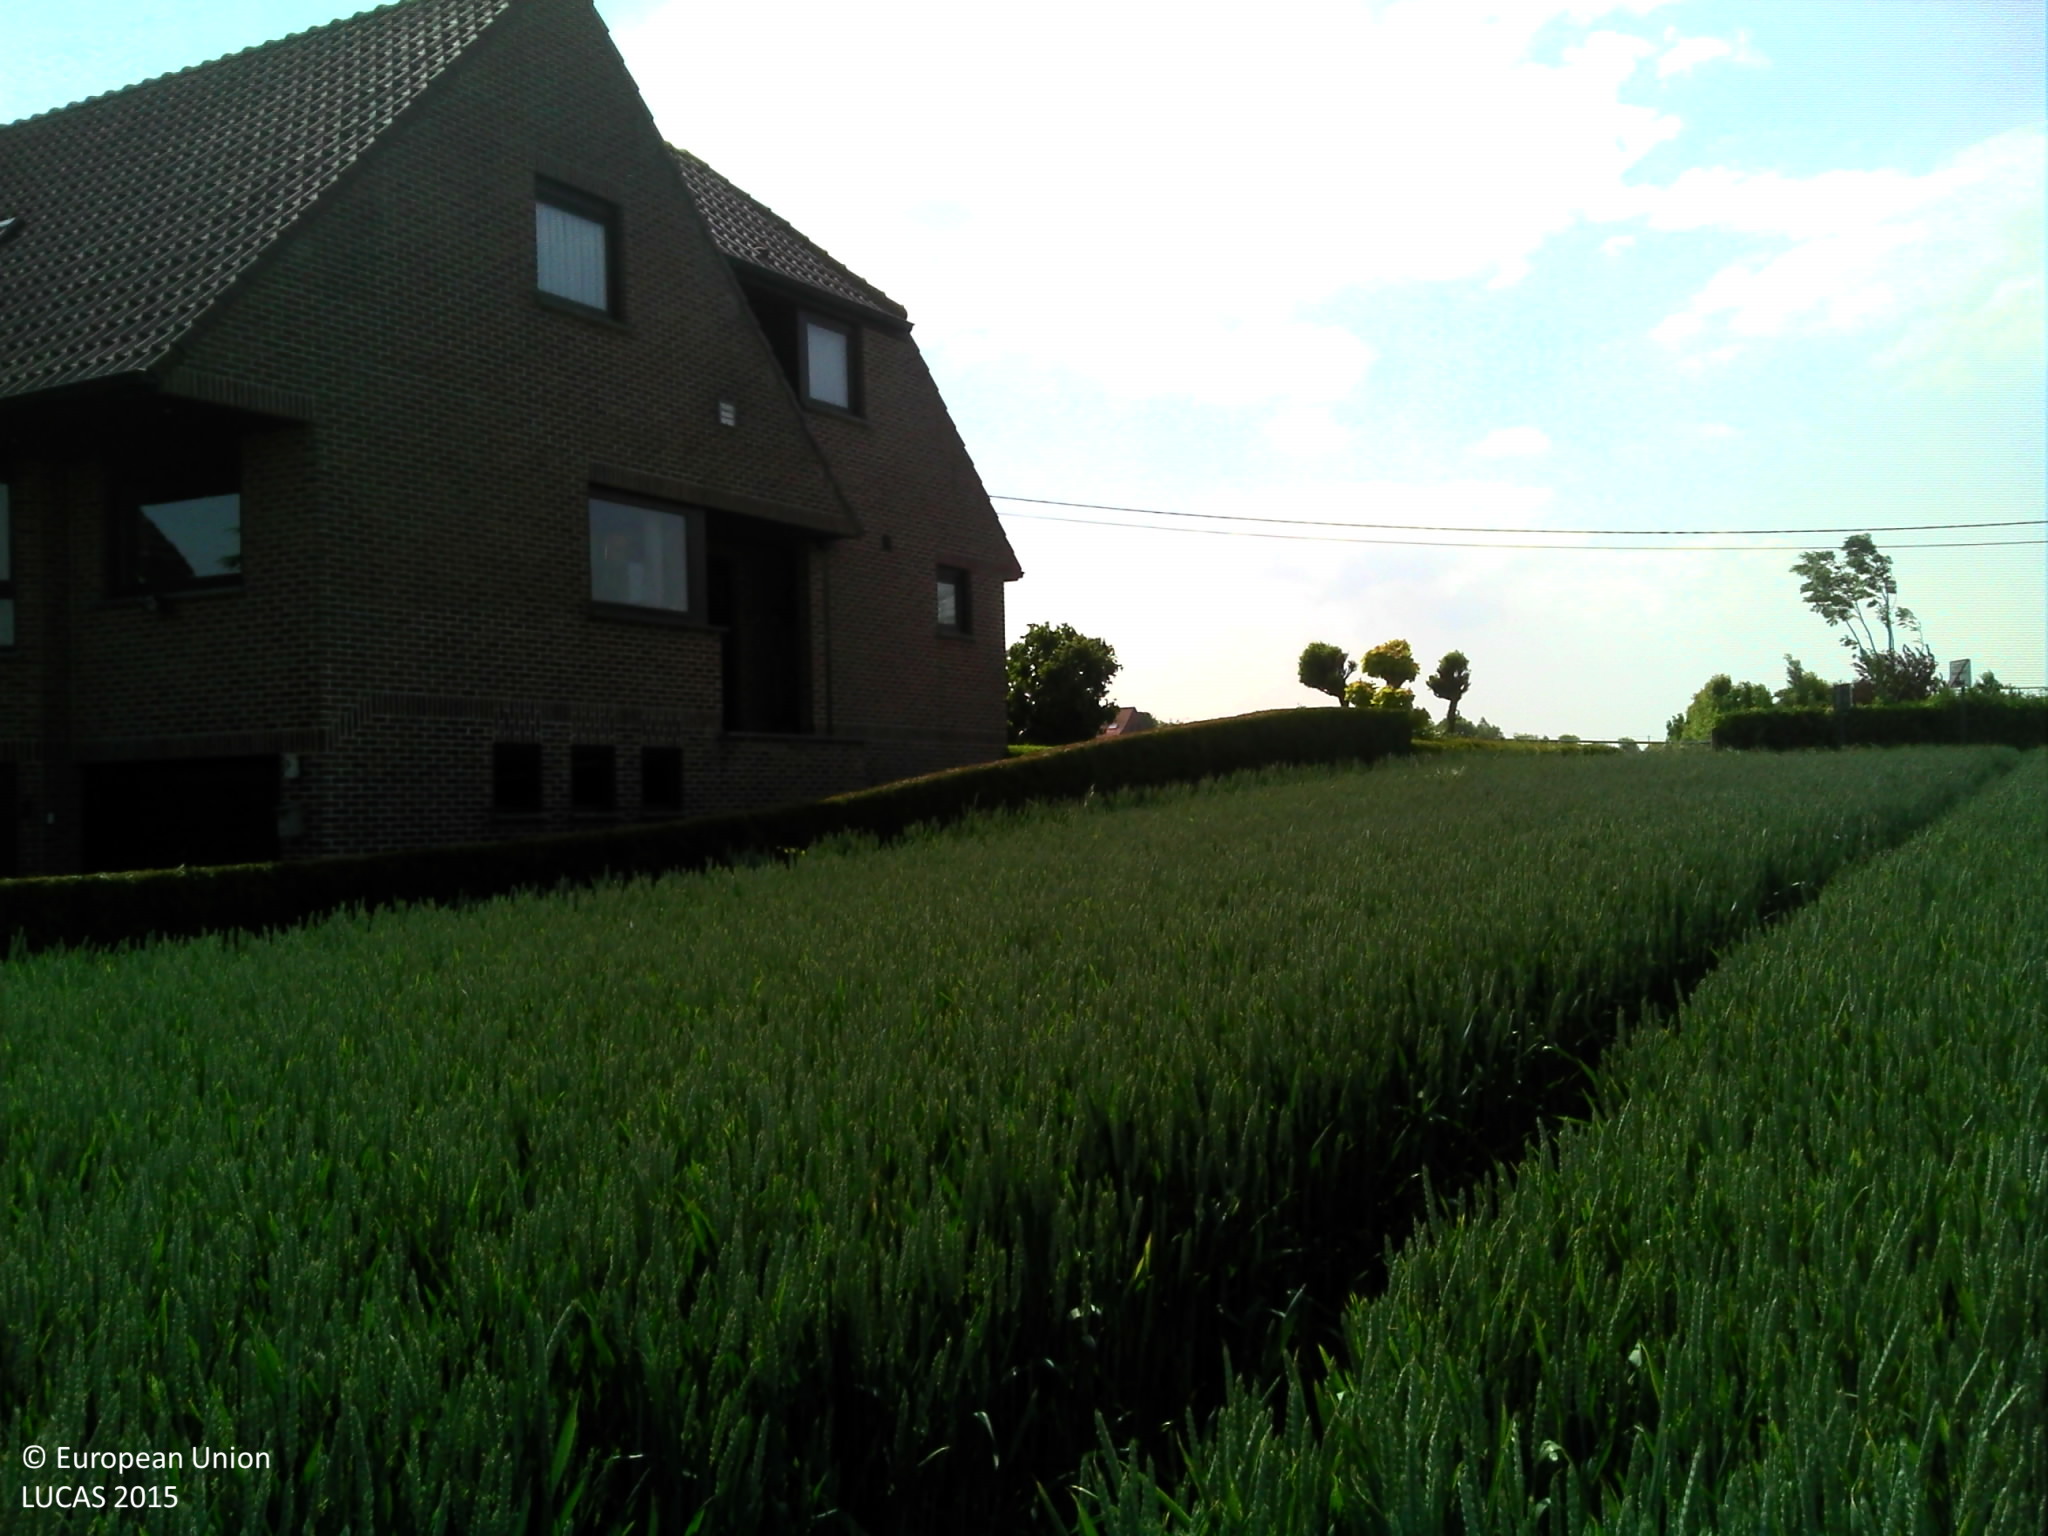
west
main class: Cropland
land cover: Common wheat
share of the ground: > 75 %
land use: Agriculture (excluding fallow land and kitchen gardens)
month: June
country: BE
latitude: 50.7885
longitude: 2.8255
